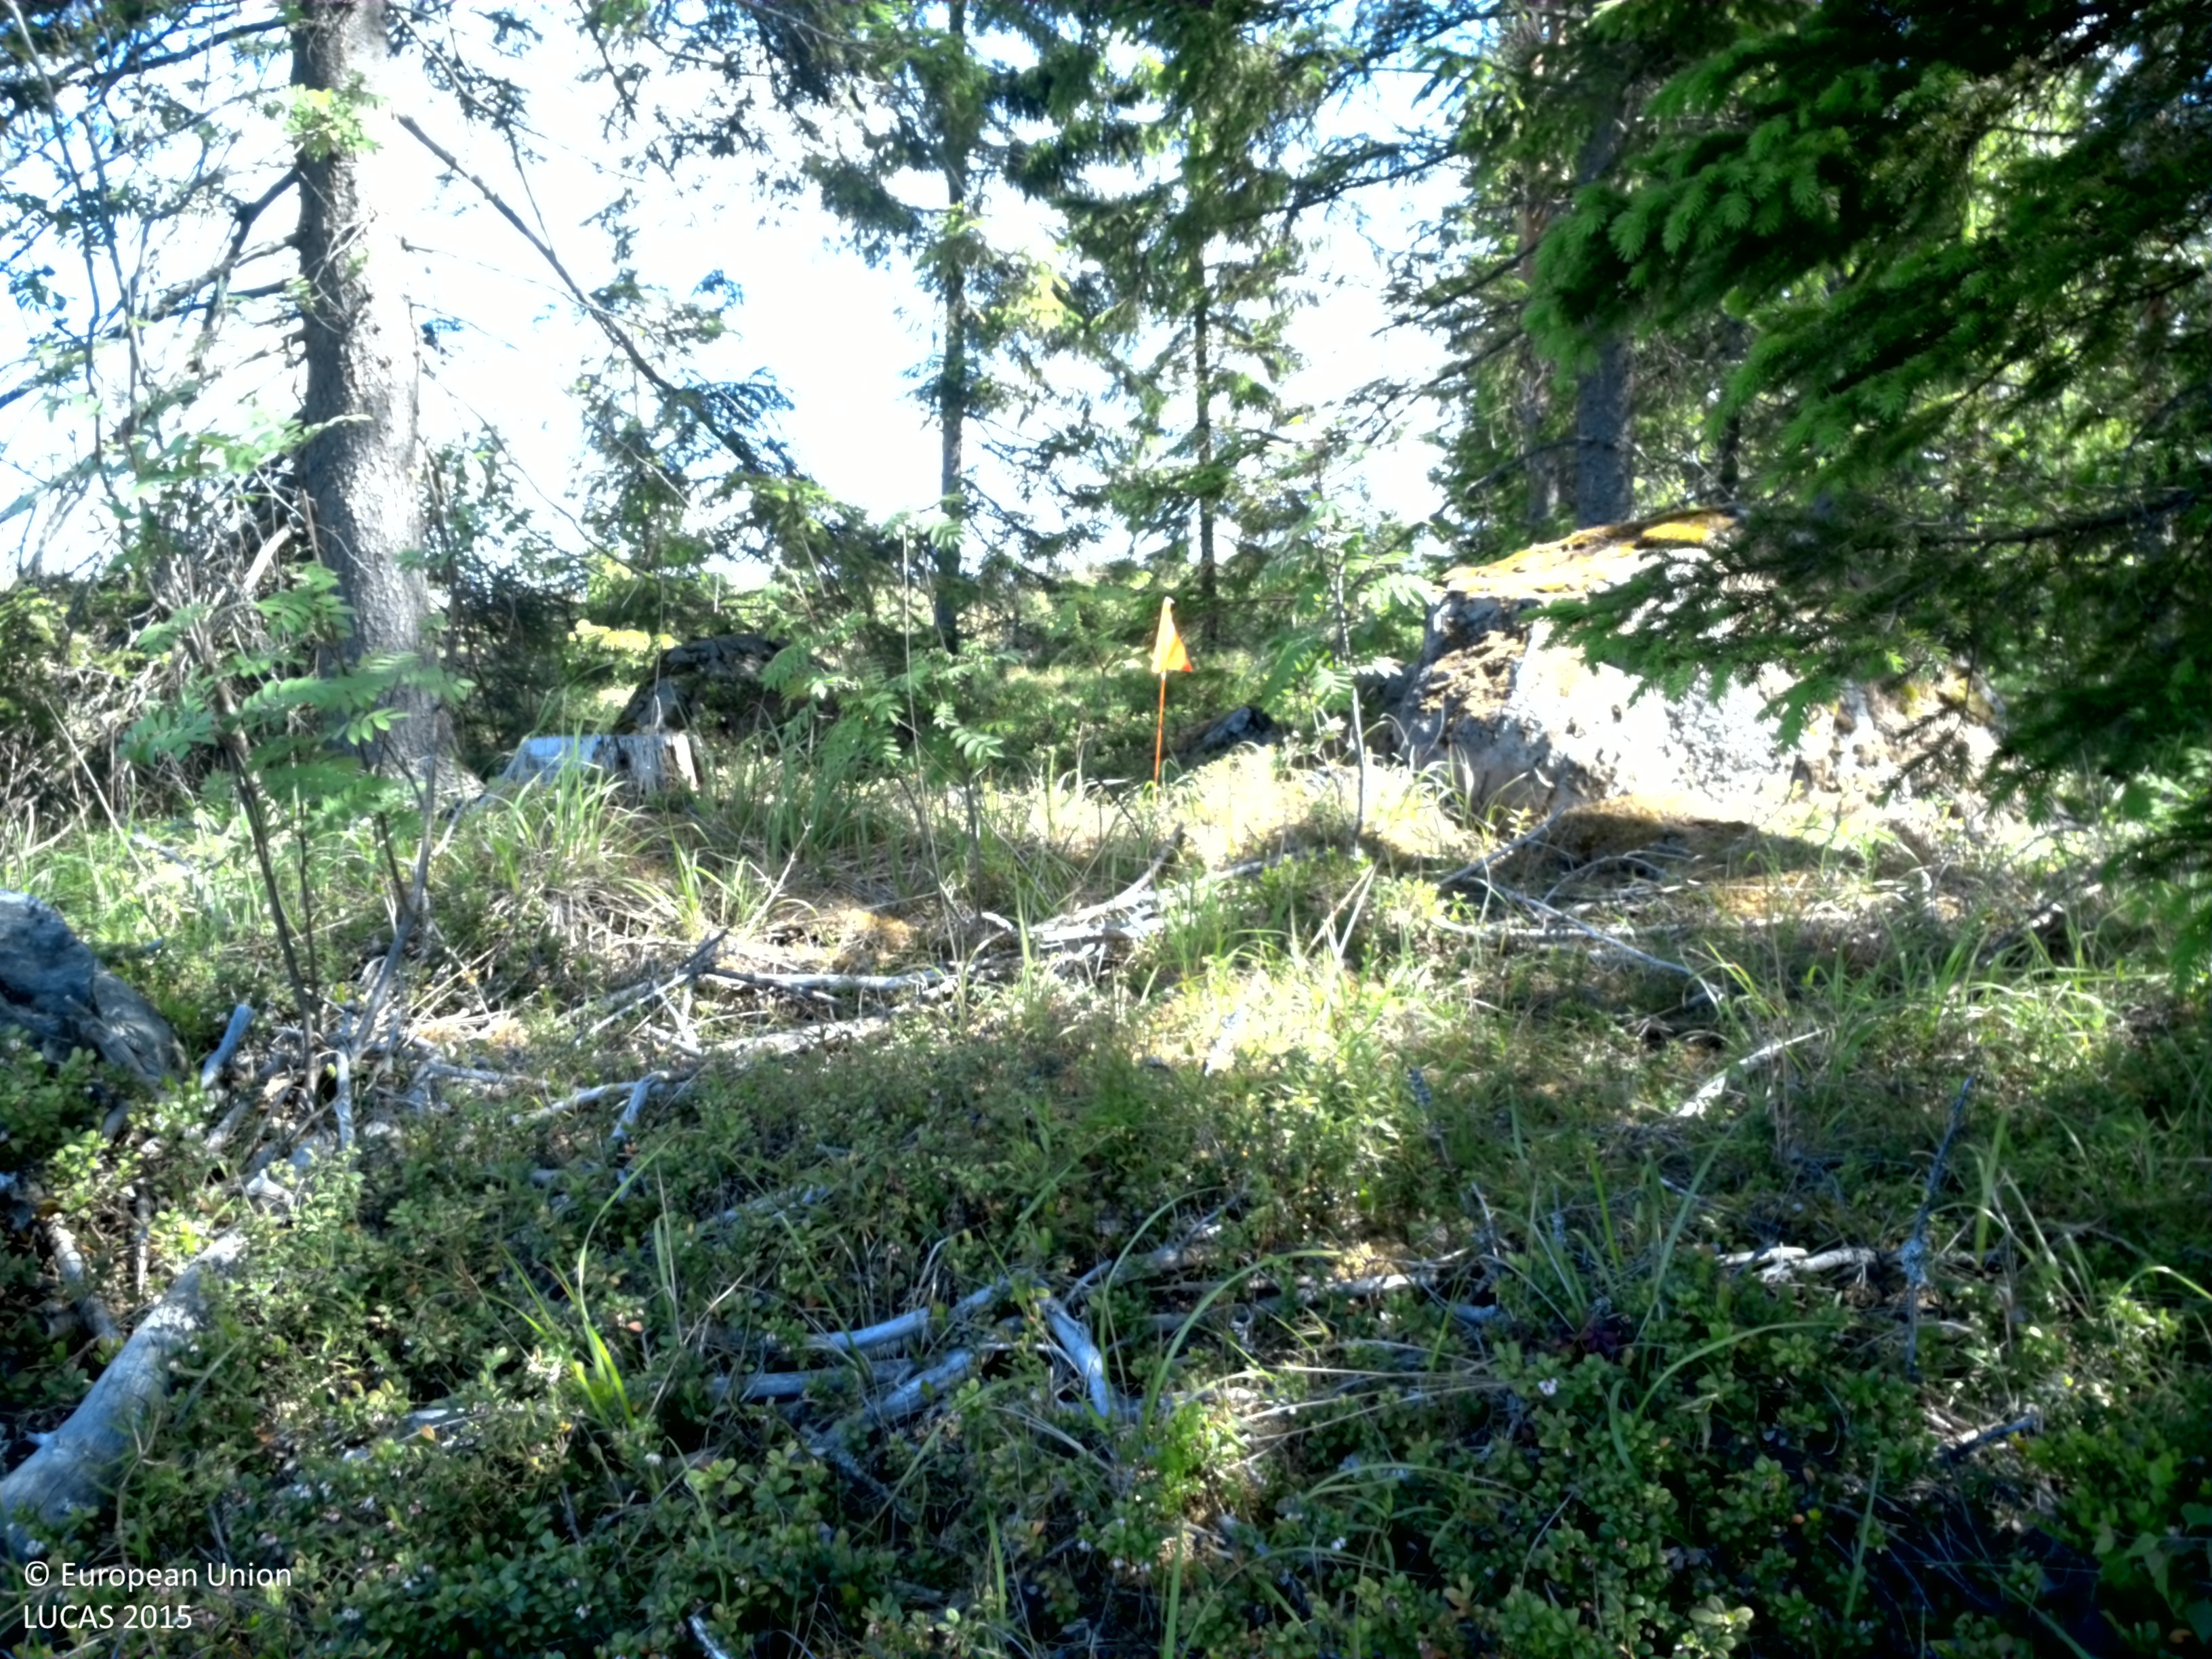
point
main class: Woodland
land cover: Spruce dominated mixed woodland
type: boreal forest
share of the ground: 50 - 75 %
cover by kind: coniferous forest trees 45 %, herbaceous plants 30 %, broadleaved forest trees 15 %, lichens and mosses 10 %
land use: Forestry
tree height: > 5 m
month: June
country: SE
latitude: 60.2554
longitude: 17.0922
